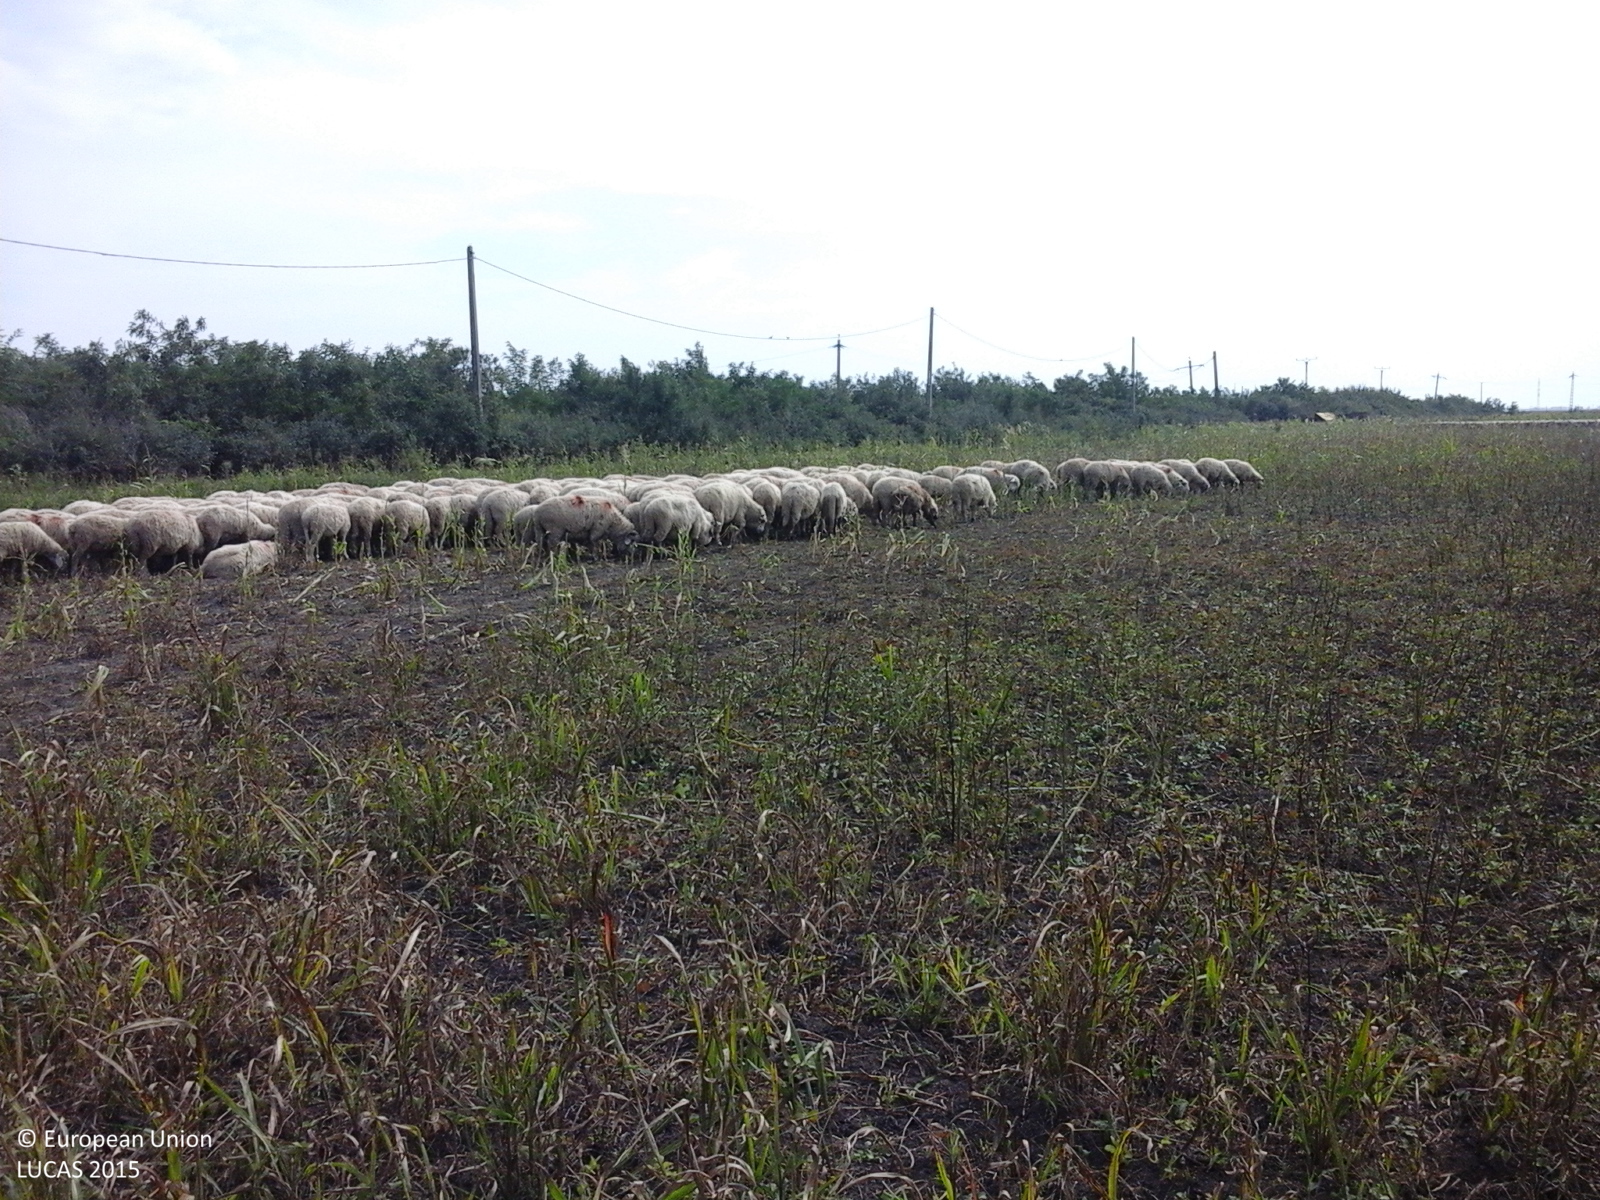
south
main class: Grassland
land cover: Spontaneously vegetated surfaces
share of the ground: > 75 %
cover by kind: herbaceous plants 100 %
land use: Agriculture (excluding fallow land and kitchen gardens)
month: August
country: RO
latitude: 46.2215
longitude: 21.1424
